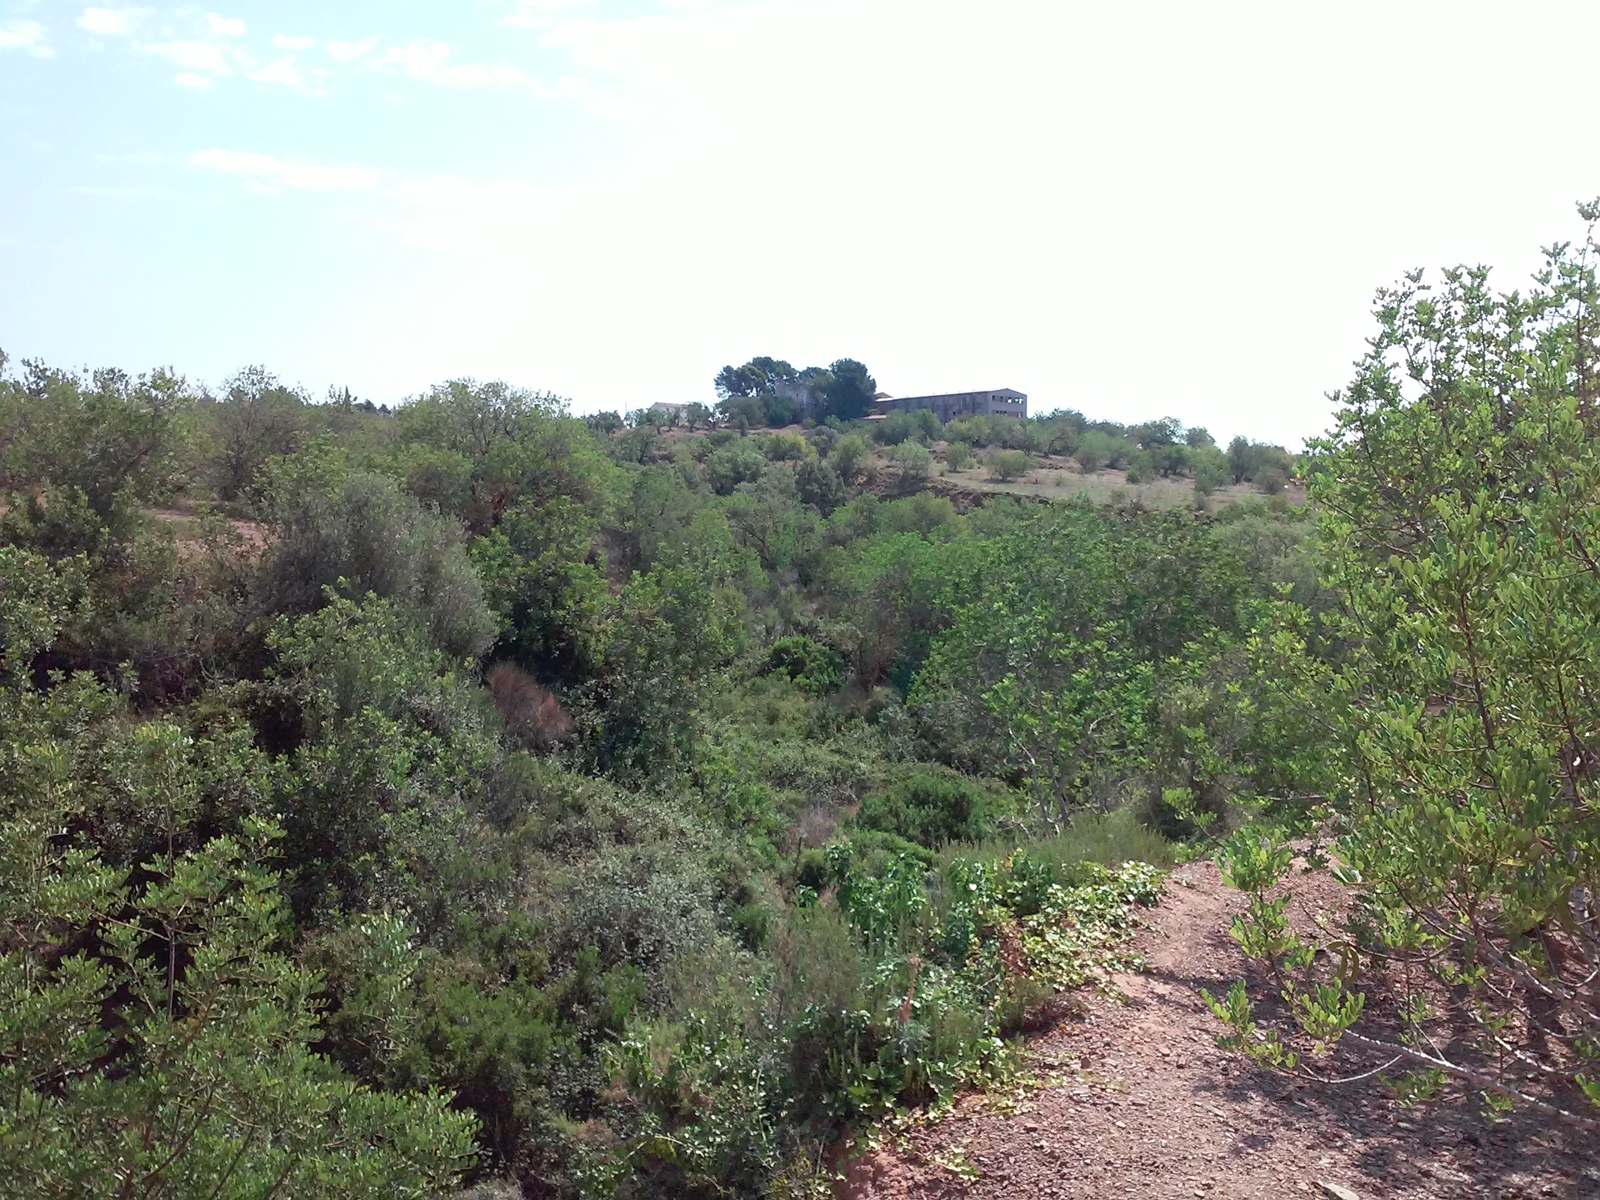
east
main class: Cropland
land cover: Permanent industrial crops
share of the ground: > 75 %
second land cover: Other bare soil
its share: > 75 %
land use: Agriculture (excluding fallow land and kitchen gardens)
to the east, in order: Permanent industrial crops; Other bare soil; Shrubland with sparse tree cover; Rivers and streams; Shrubland with sparse tree cover; Rivers and streams; Broadleaved woodland; Permanent industrial crops; Shrubland with sparse tree cover; Permanent industrial crops; Nuts trees
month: June
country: ES
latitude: 41.2909
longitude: 1.2158
